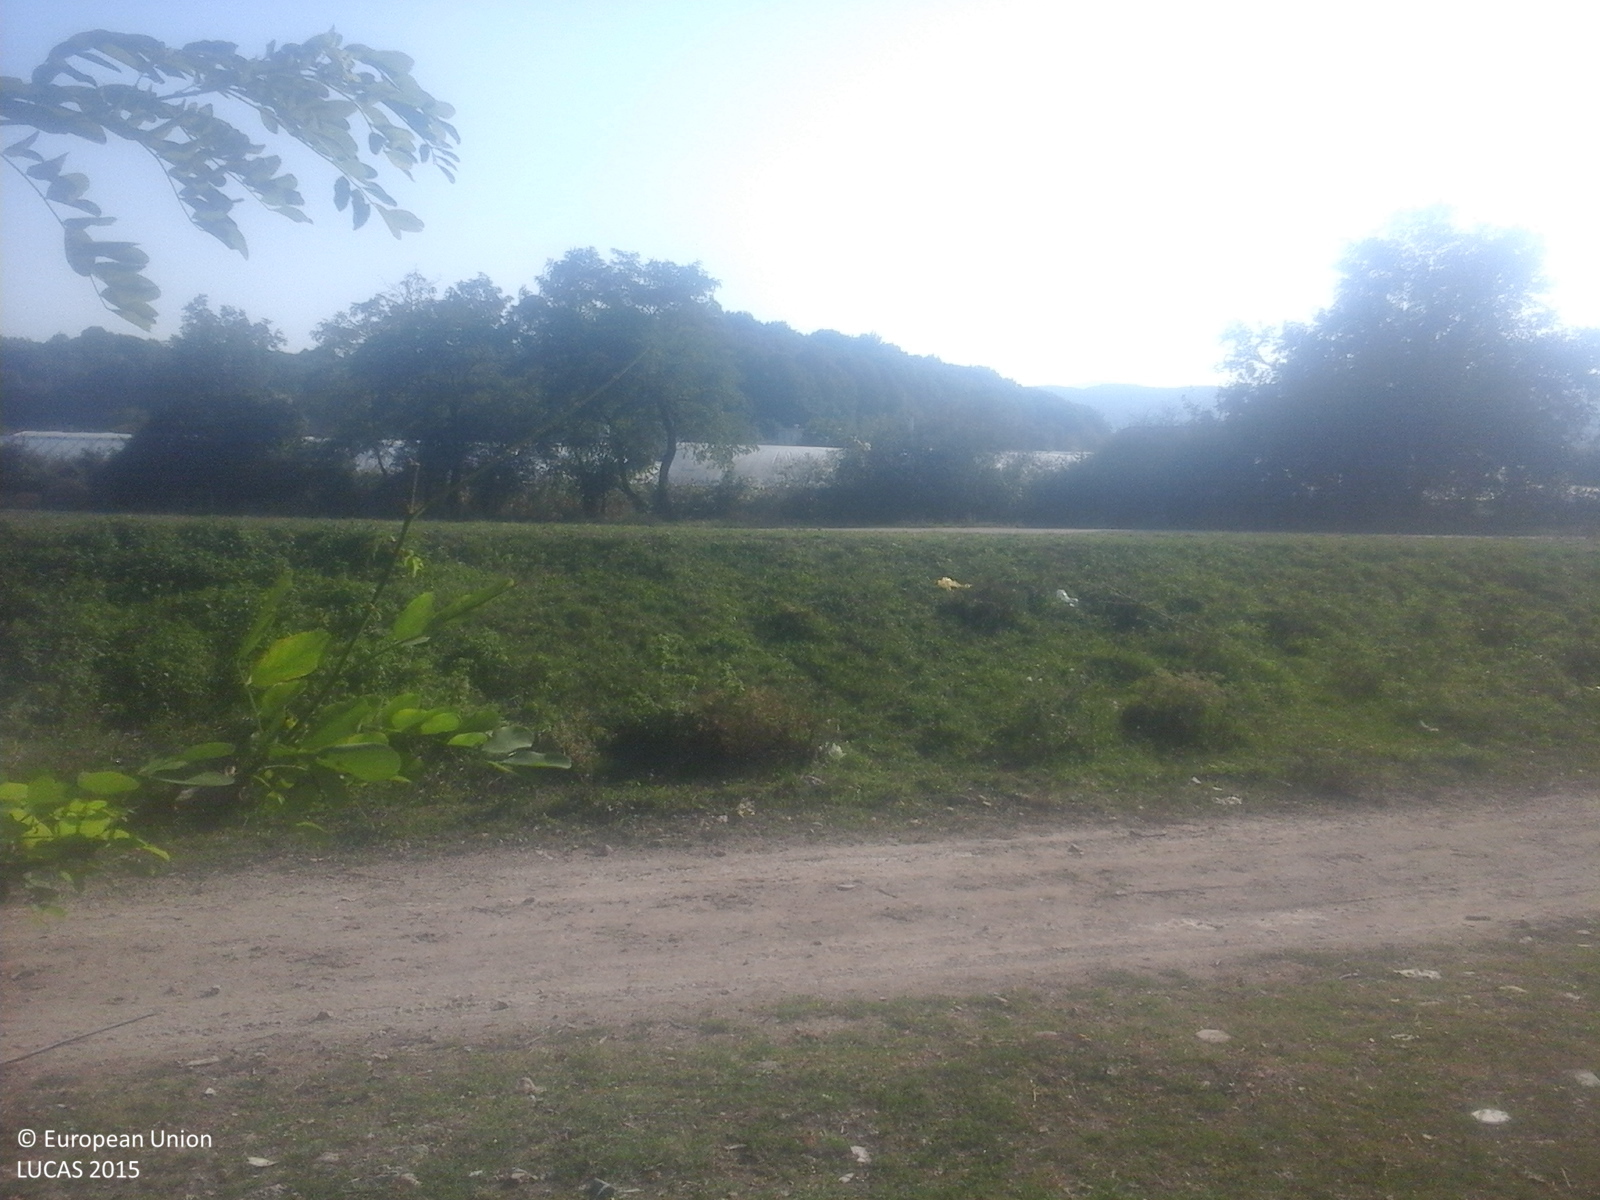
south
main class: Woodland
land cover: Broadleaved woodland
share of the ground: > 75 %
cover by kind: broadleaved forest trees 100 %
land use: Forestry
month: September
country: RO
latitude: 46.6319
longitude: 22.3676
